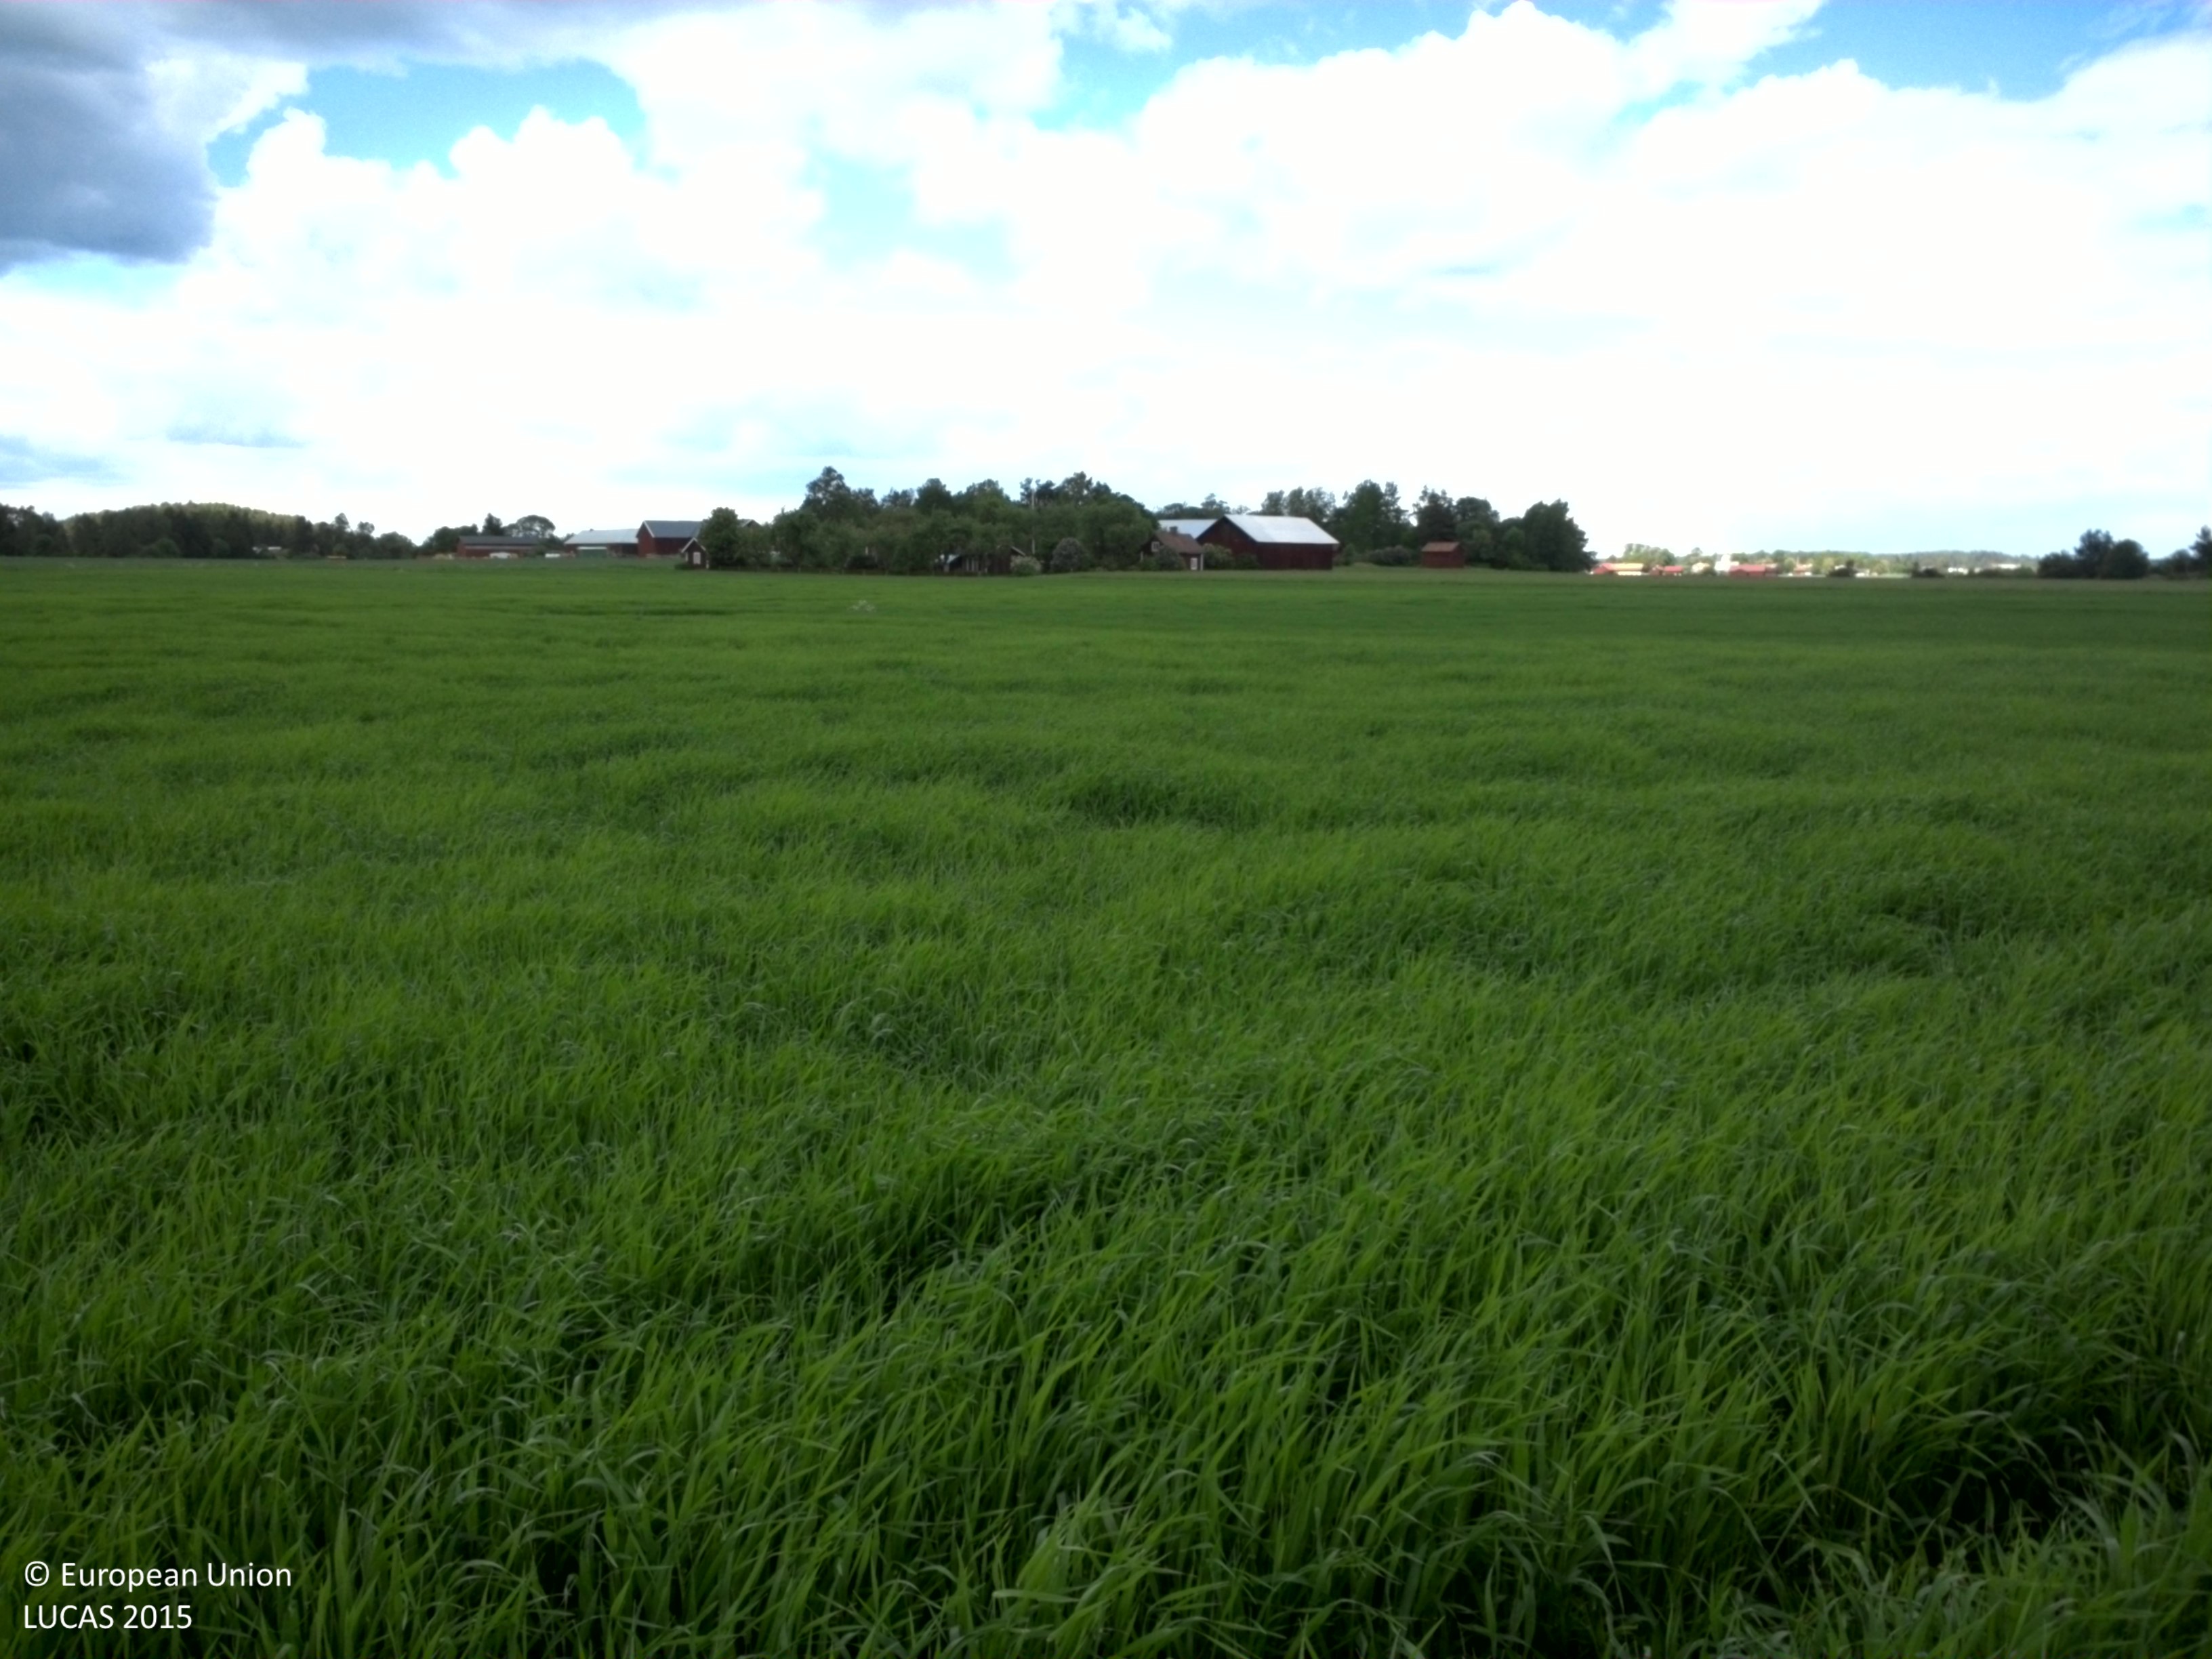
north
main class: Cropland
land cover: Barley
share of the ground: 25 - 50 %
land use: Agriculture (excluding fallow land and kitchen gardens)
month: June
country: SE
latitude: 59.9094
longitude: 17.4858
